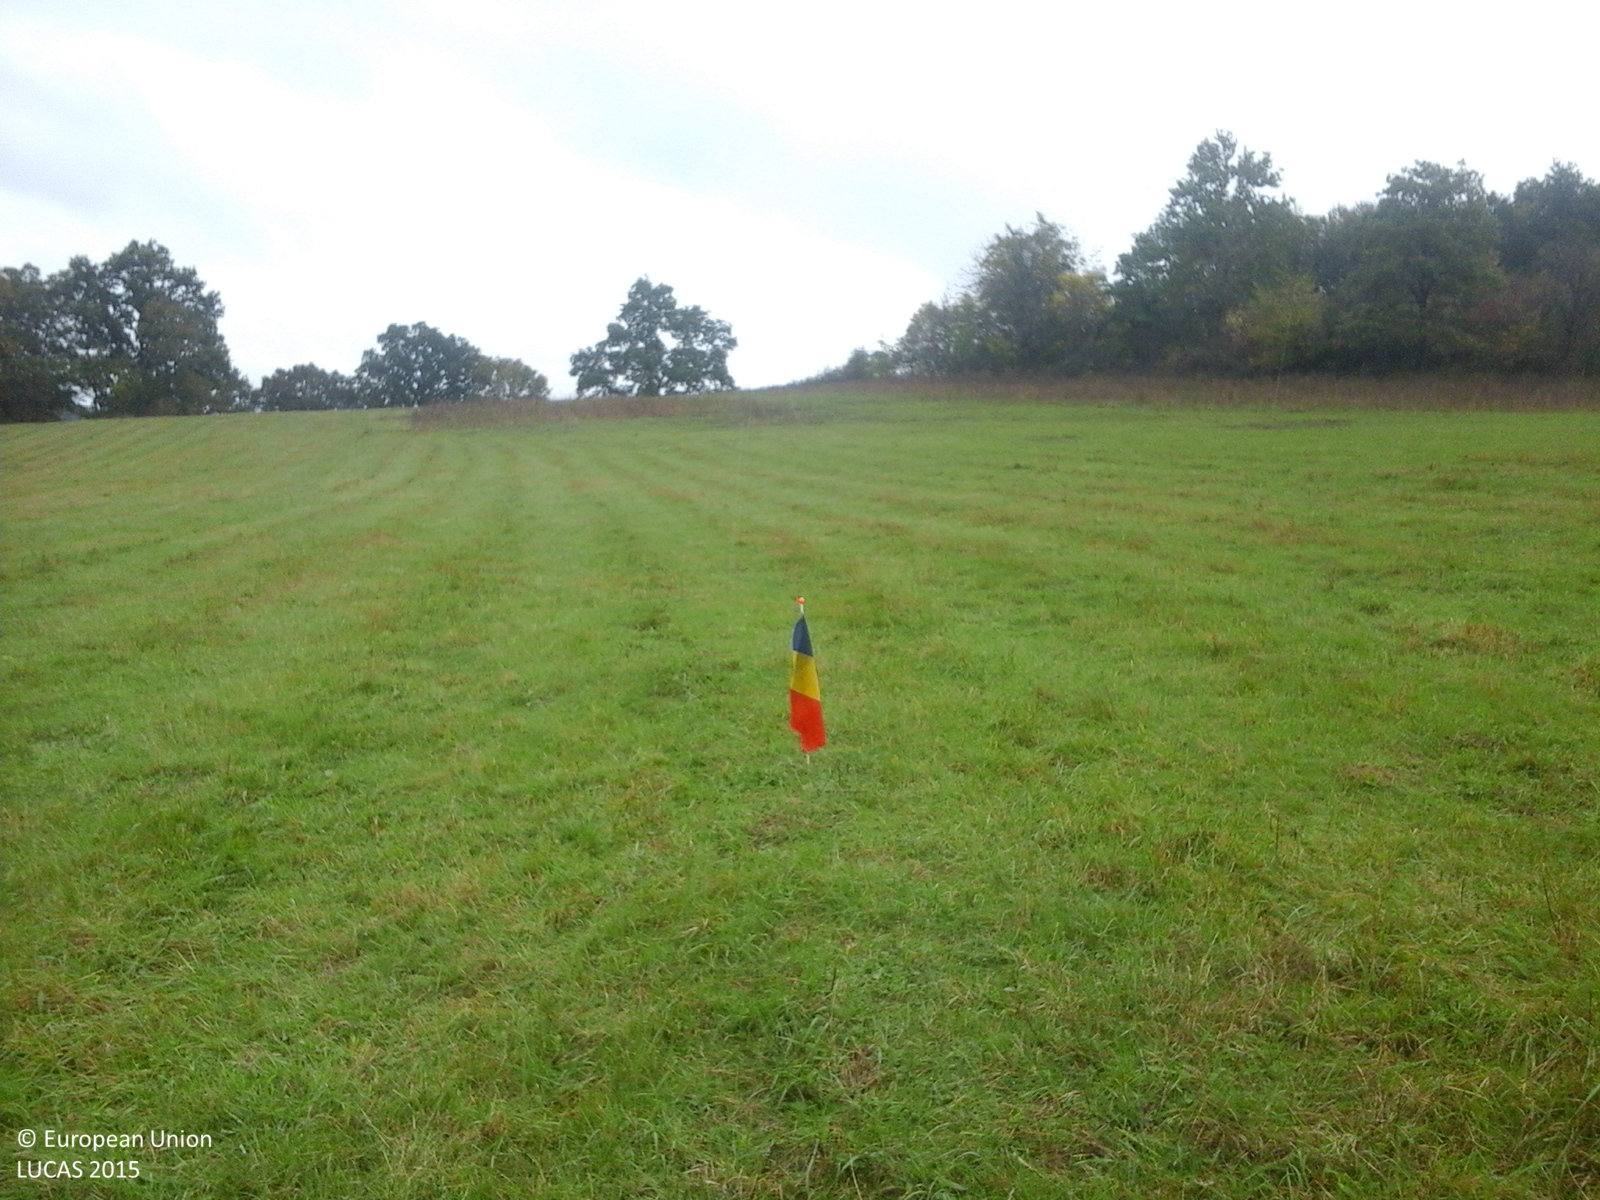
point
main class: Grassland
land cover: Grassland without tree/shrub cover
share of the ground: > 75 %
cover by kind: herbaceous plants 100 %
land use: Agriculture (excluding fallow land and kitchen gardens)
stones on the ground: < 10 %
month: October
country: RO
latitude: 45.8305
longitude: 24.6445
